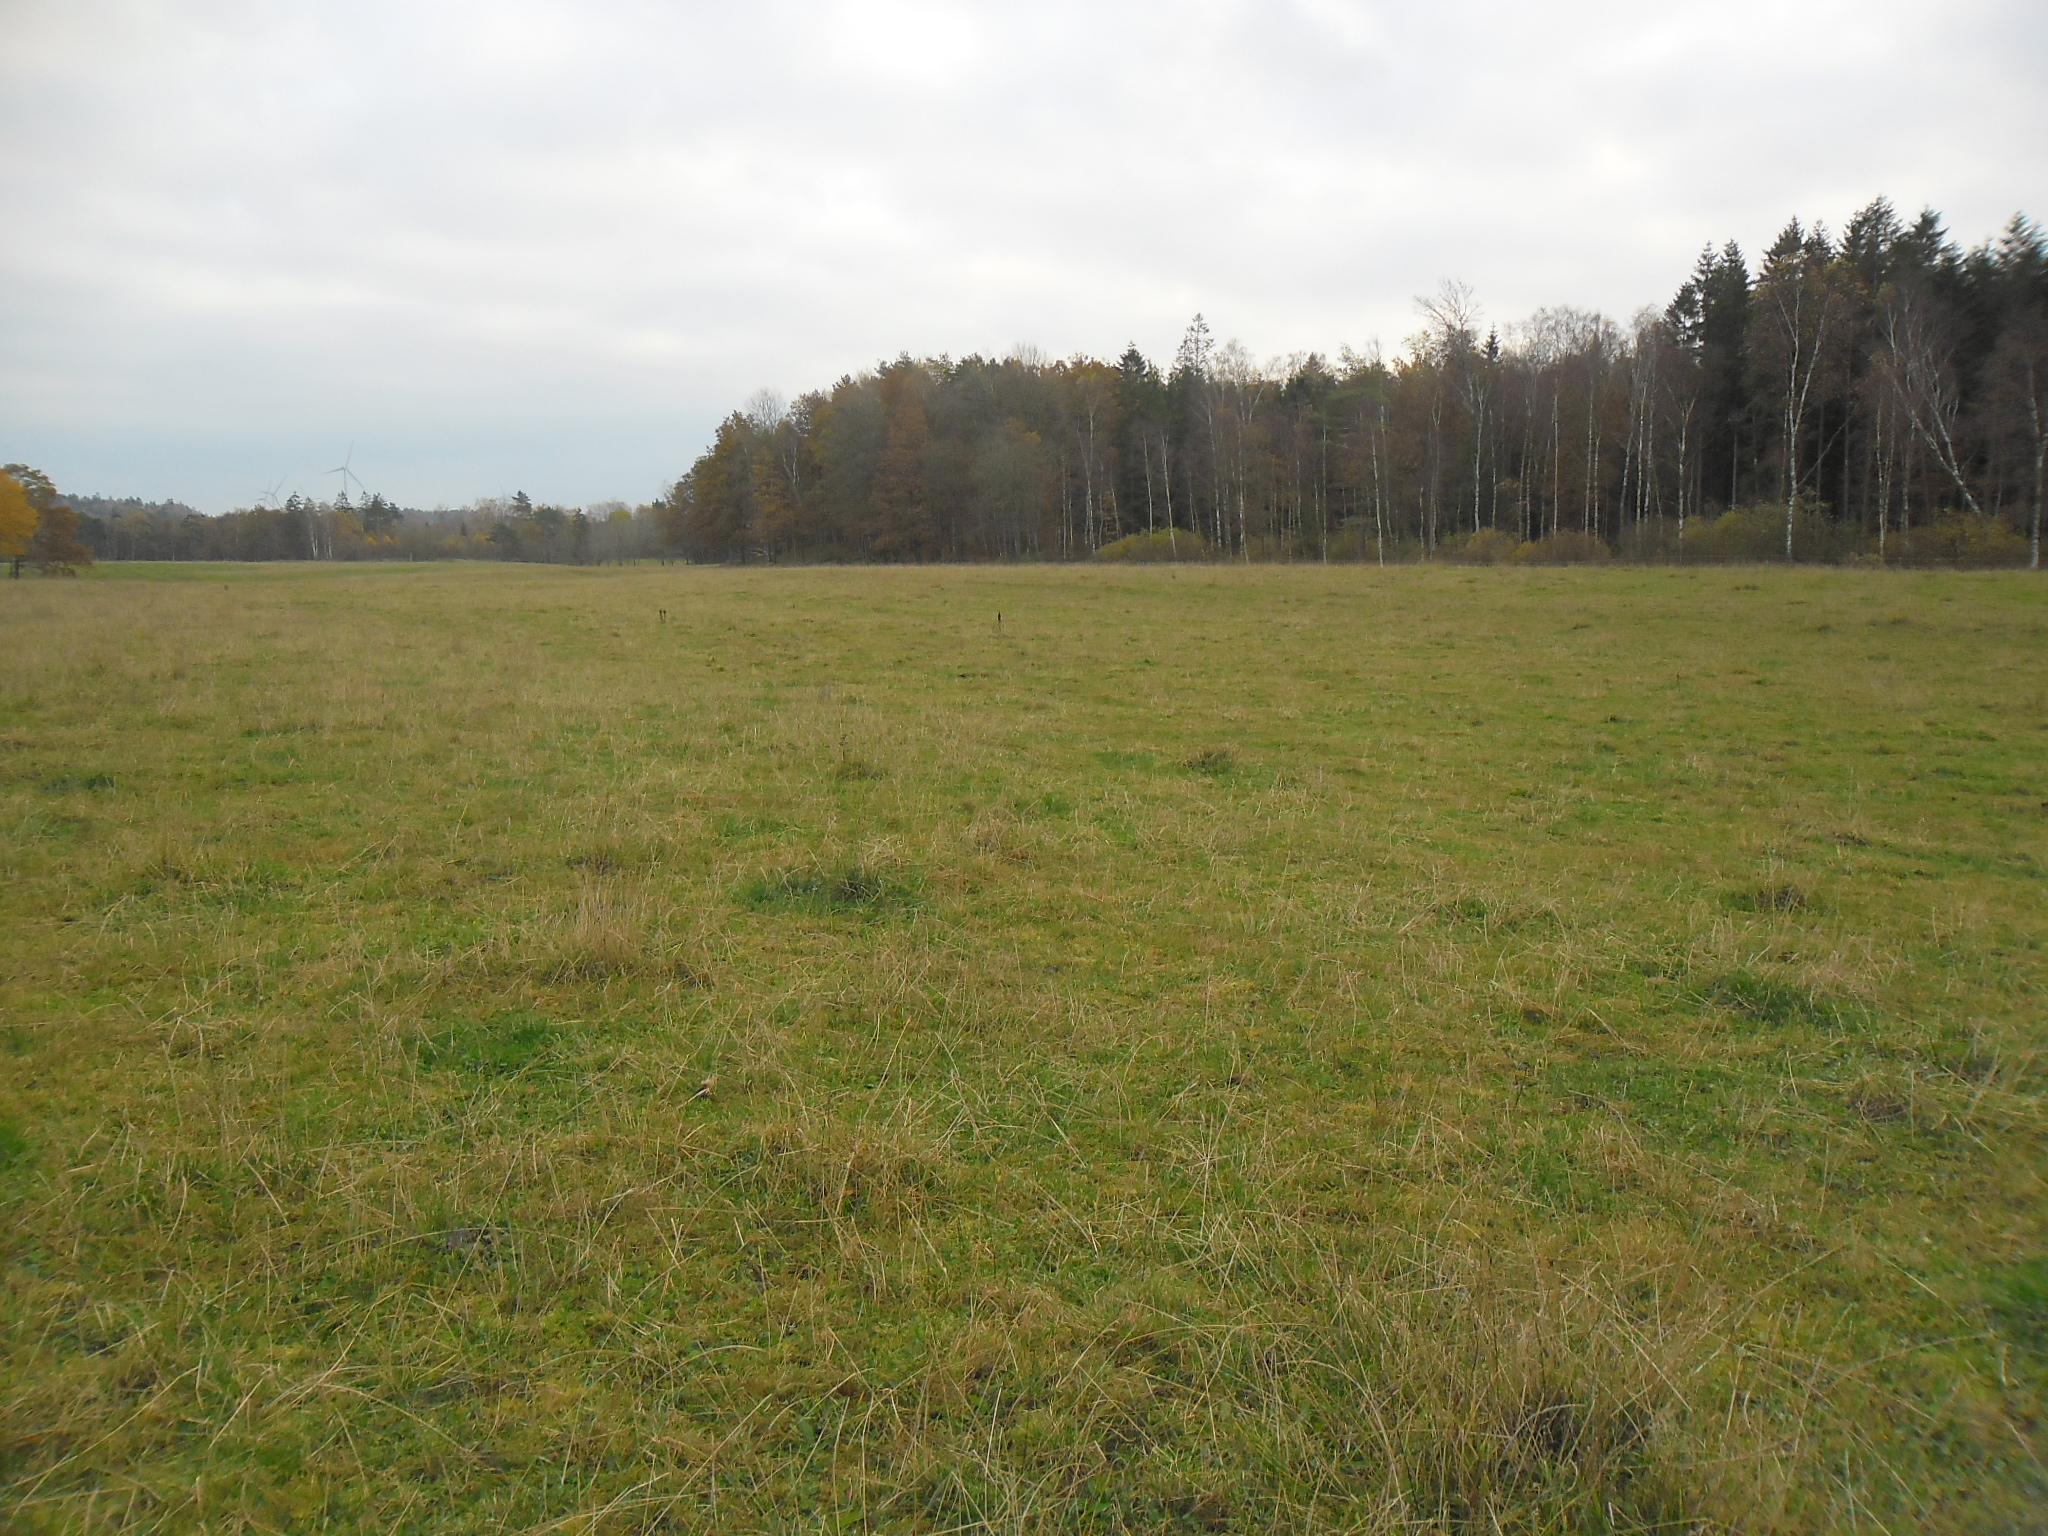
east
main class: Cropland
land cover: Temporary grasslands
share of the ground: > 75 %
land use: Agriculture (excluding fallow land and kitchen gardens)
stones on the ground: 25 - 50 %
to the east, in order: Temporary grasslands; Broadleaved woodland; Dry stone walls; Broadleaved woodland; Grassland without tree/shrub cover
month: October
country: SE
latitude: 56.5258
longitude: 13.1995
